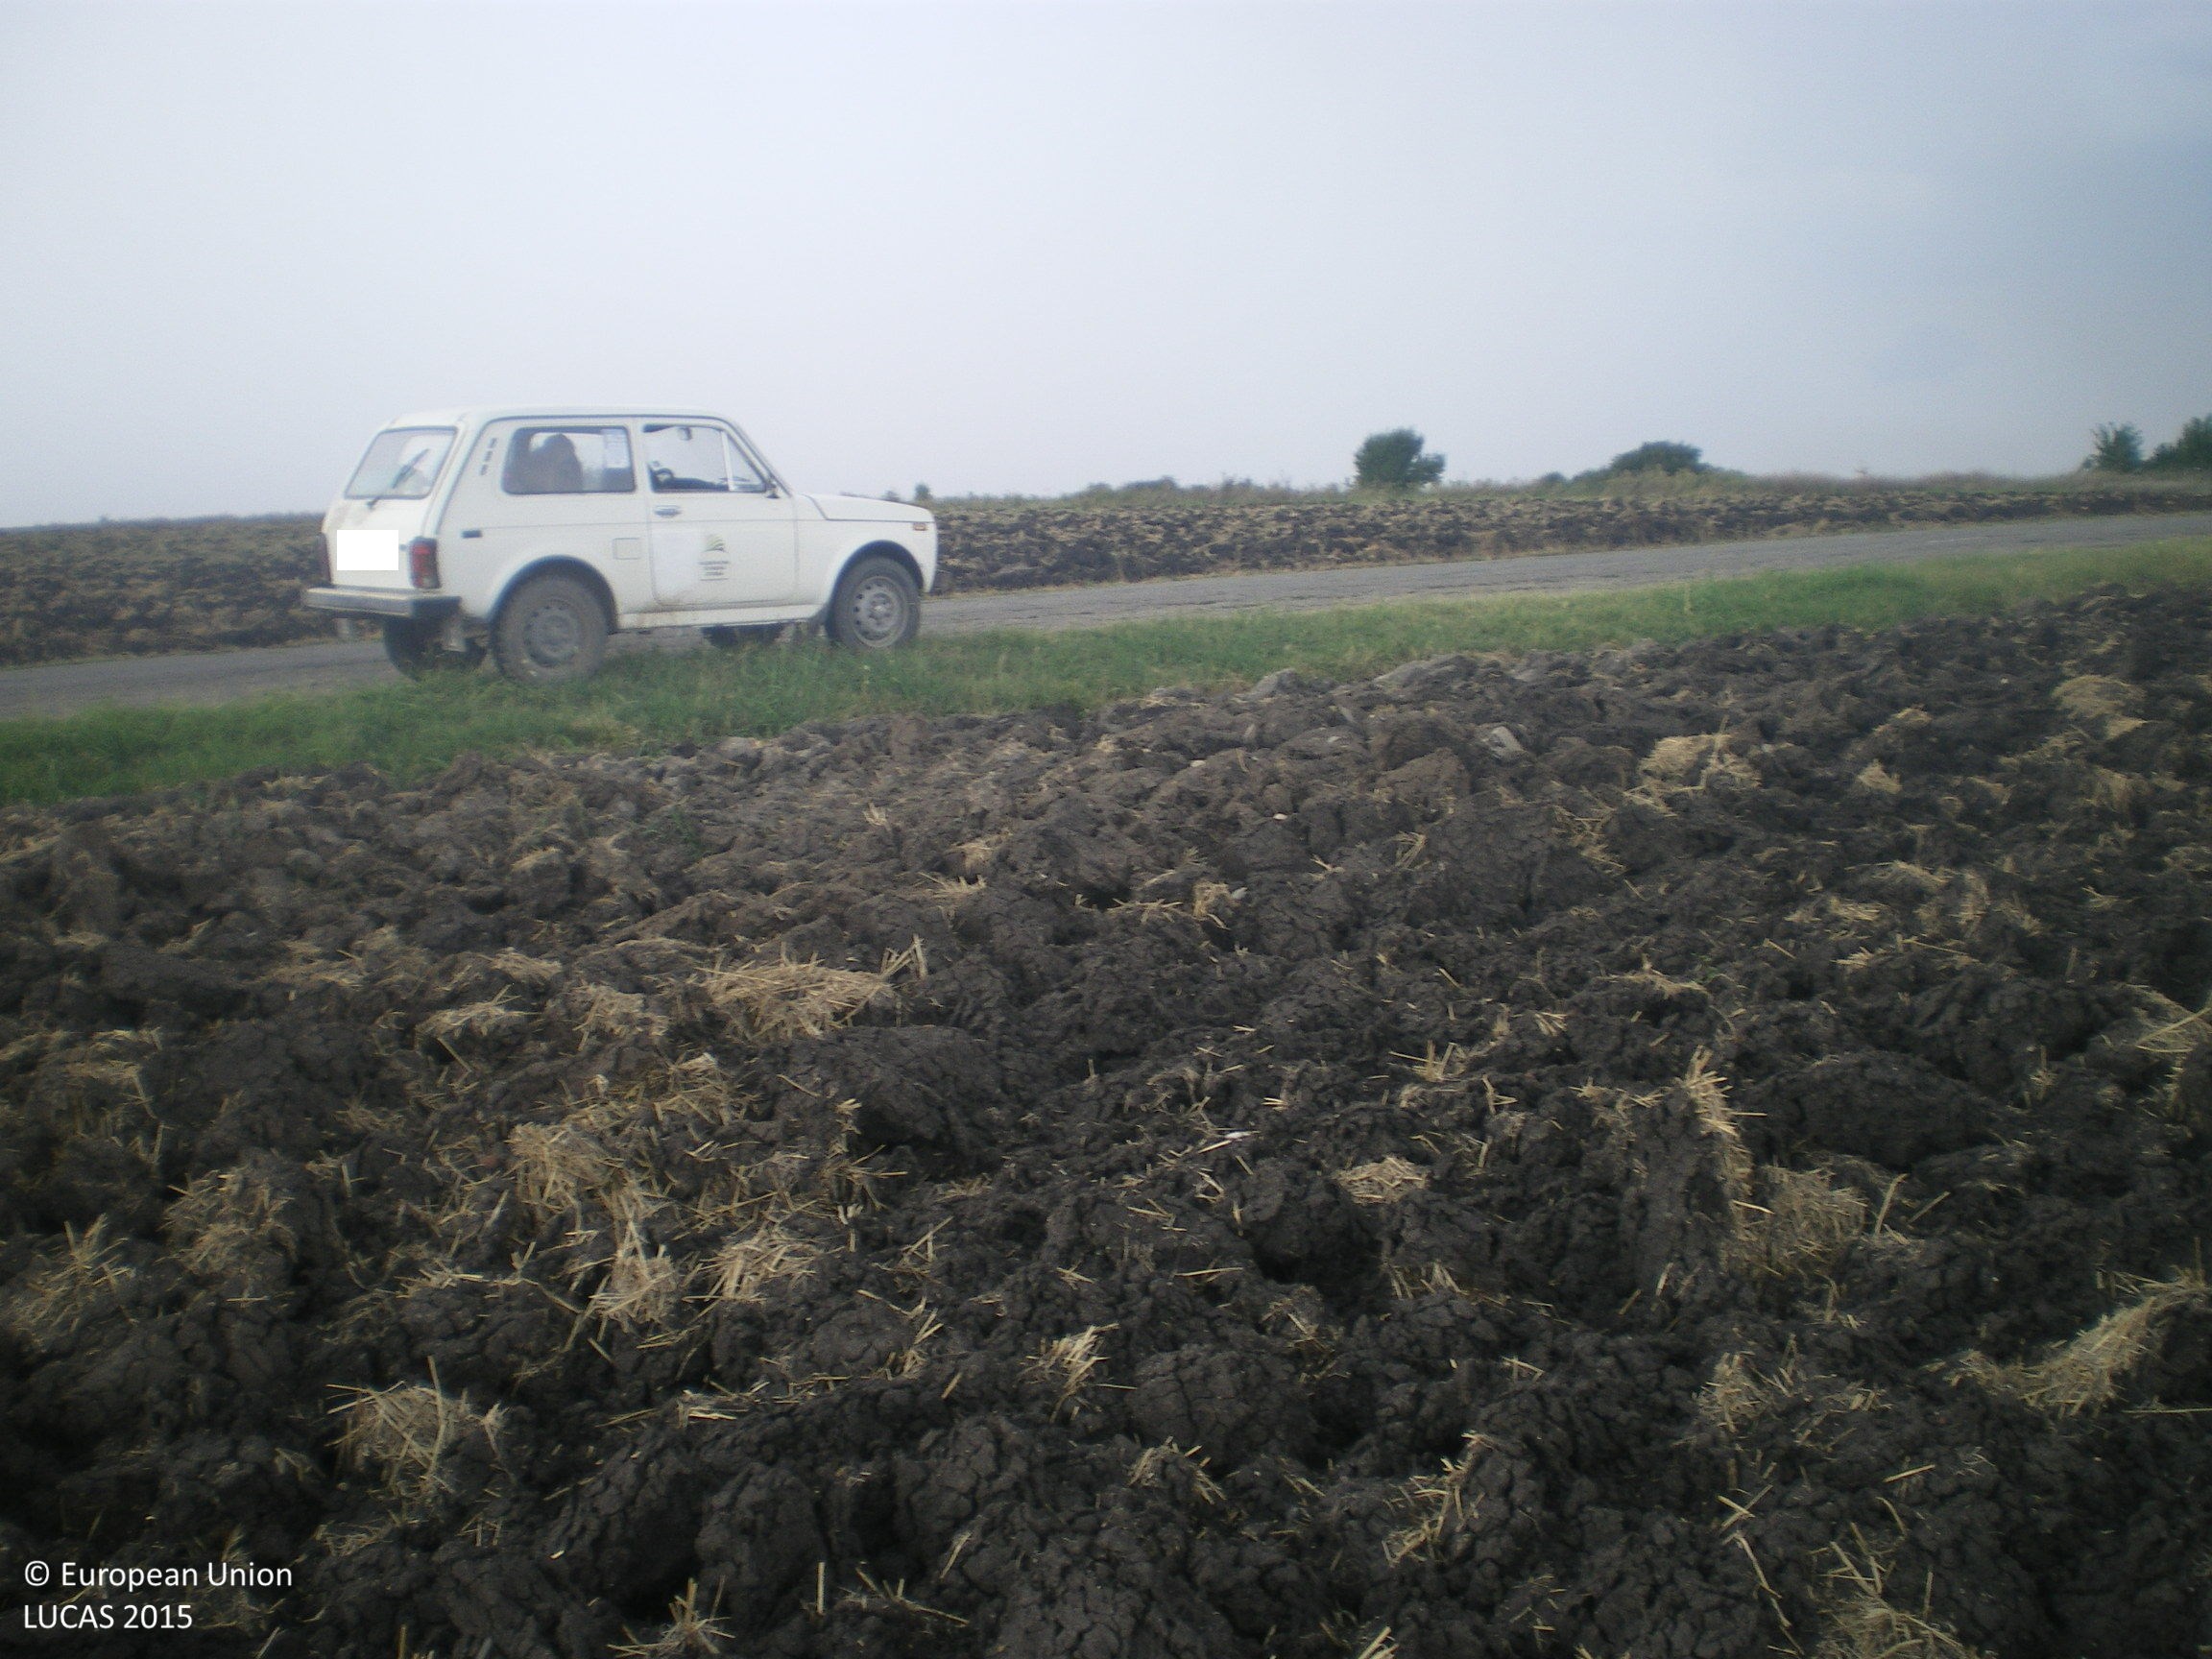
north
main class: Cropland
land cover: Oats
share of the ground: < 10 %
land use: Agriculture (excluding fallow land and kitchen gardens)
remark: Harvested field
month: August
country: BG
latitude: 42.2607
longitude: 25.8457
